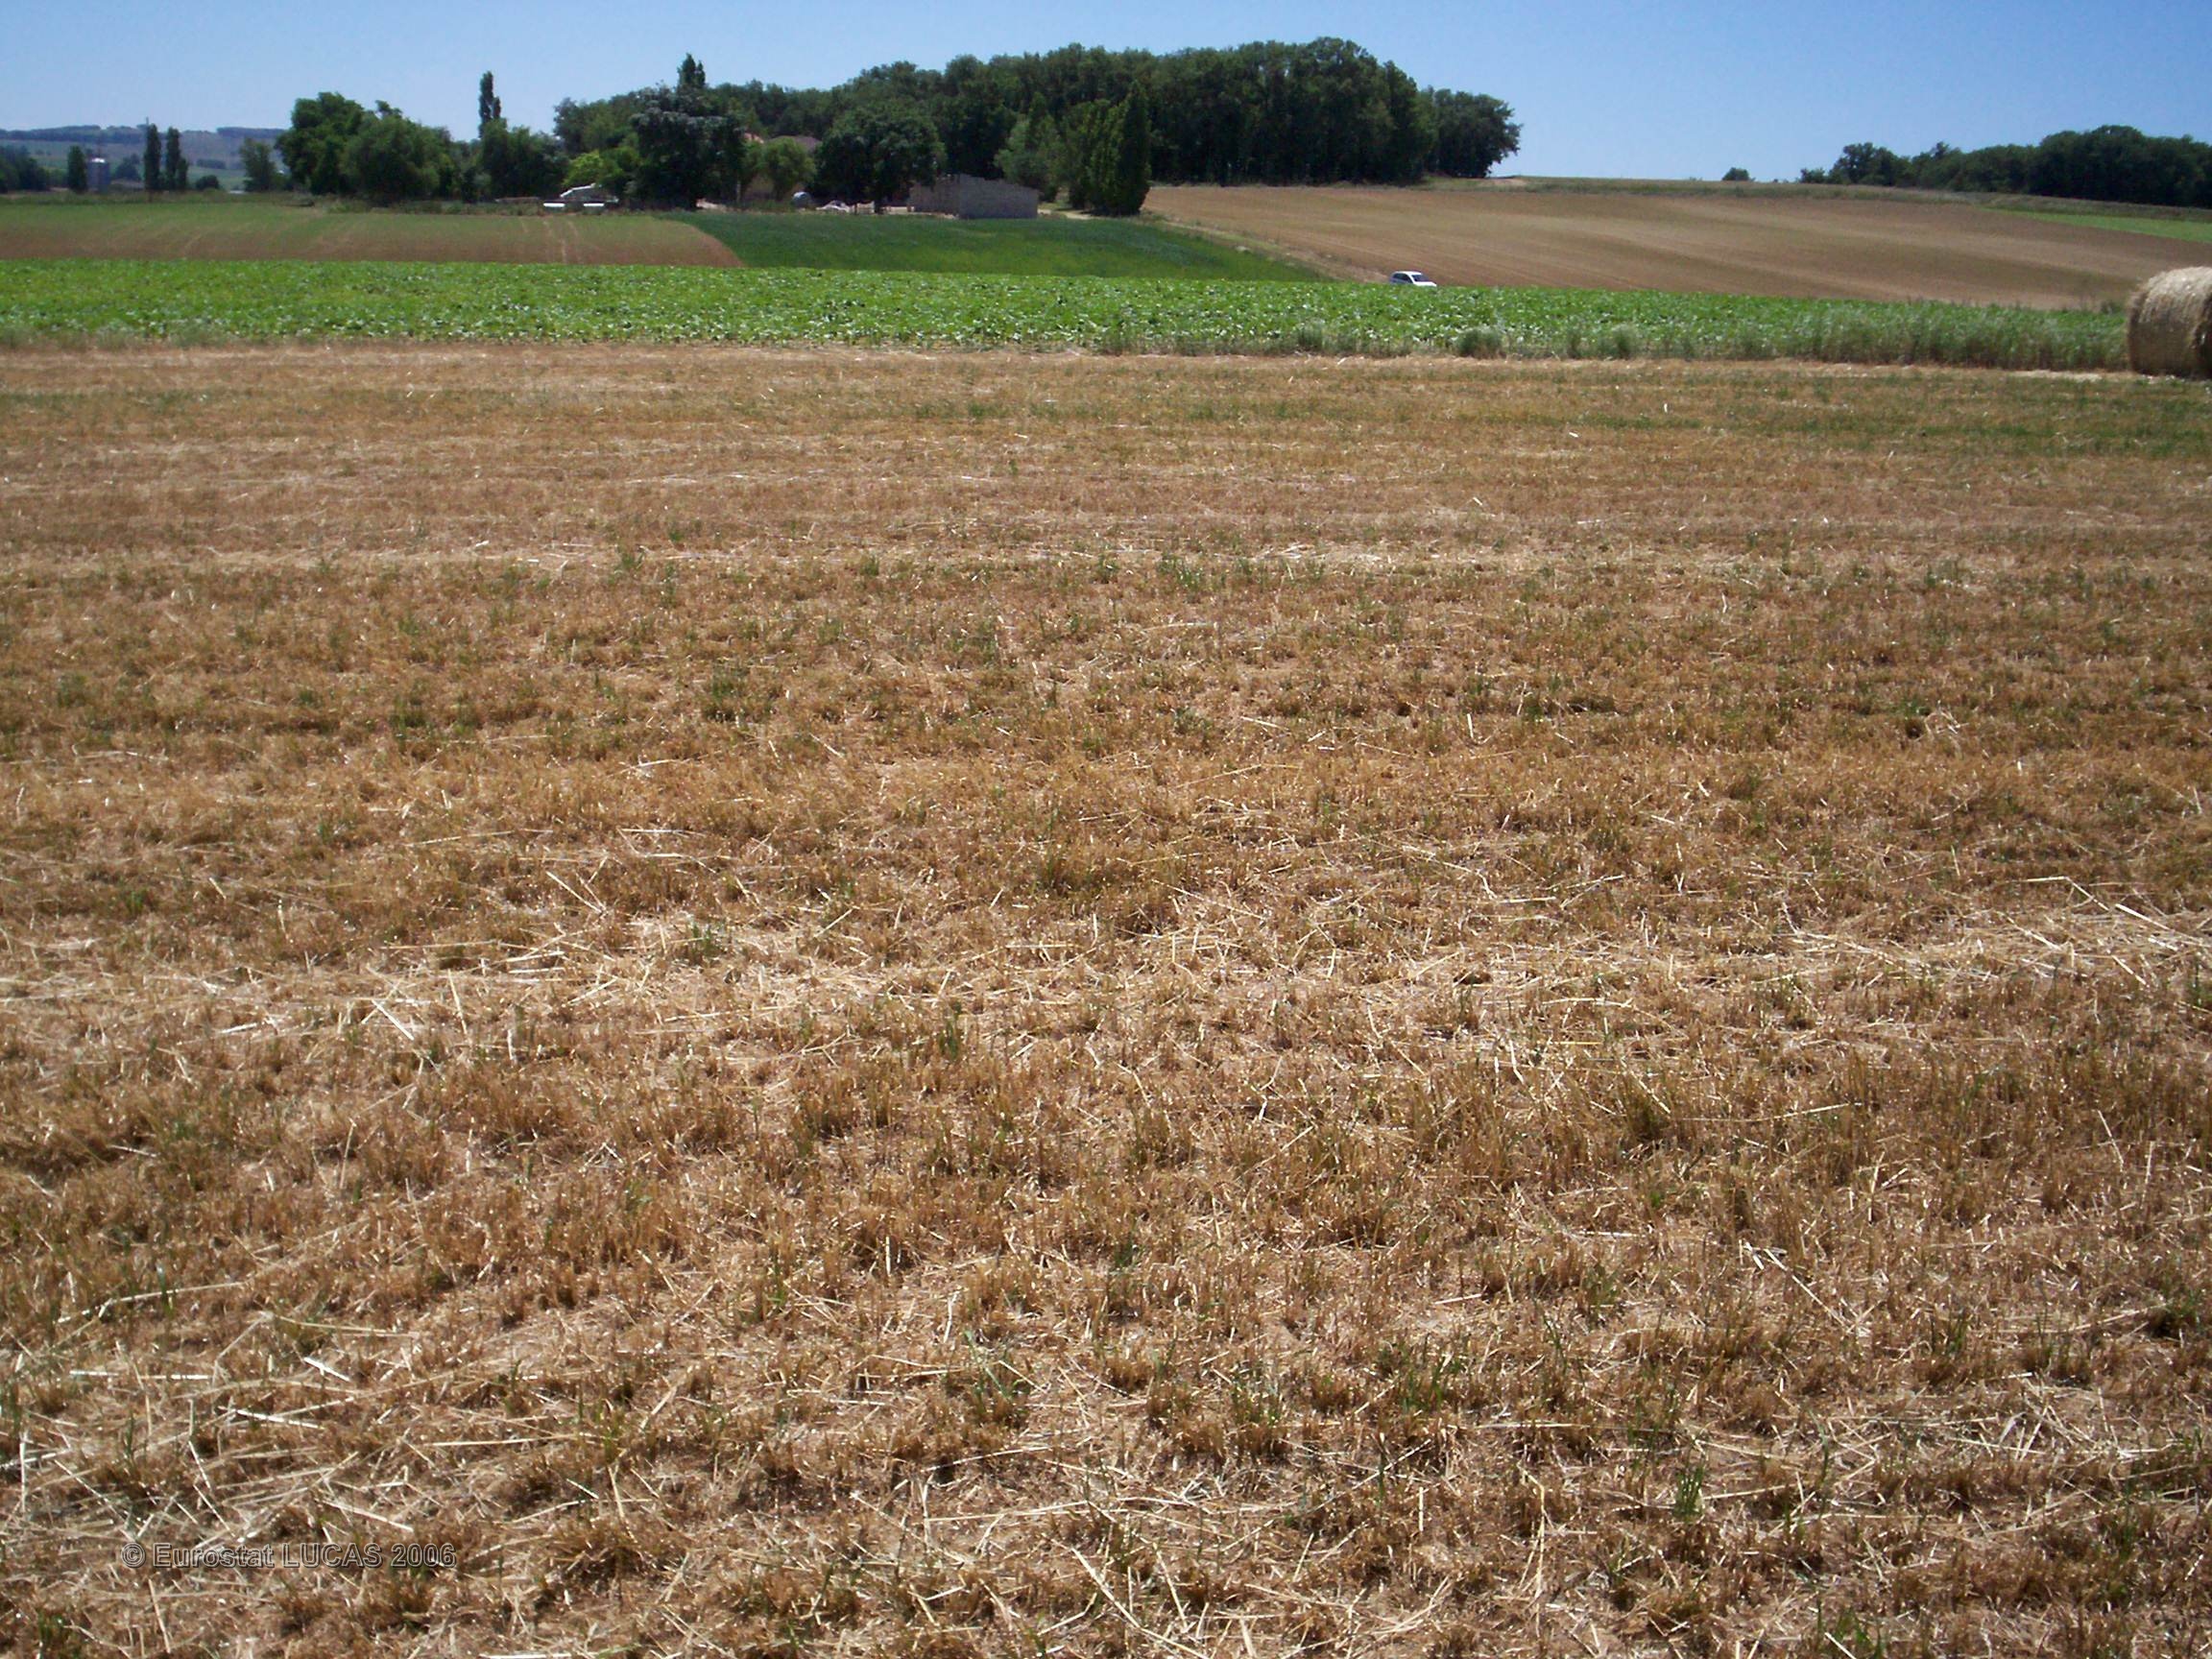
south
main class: Grassland
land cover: Grassland without tree/shrub cover
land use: Agriculture (excluding fallow land and kitchen gardens)
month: June
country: FR
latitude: 43.9961
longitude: 0.8066
